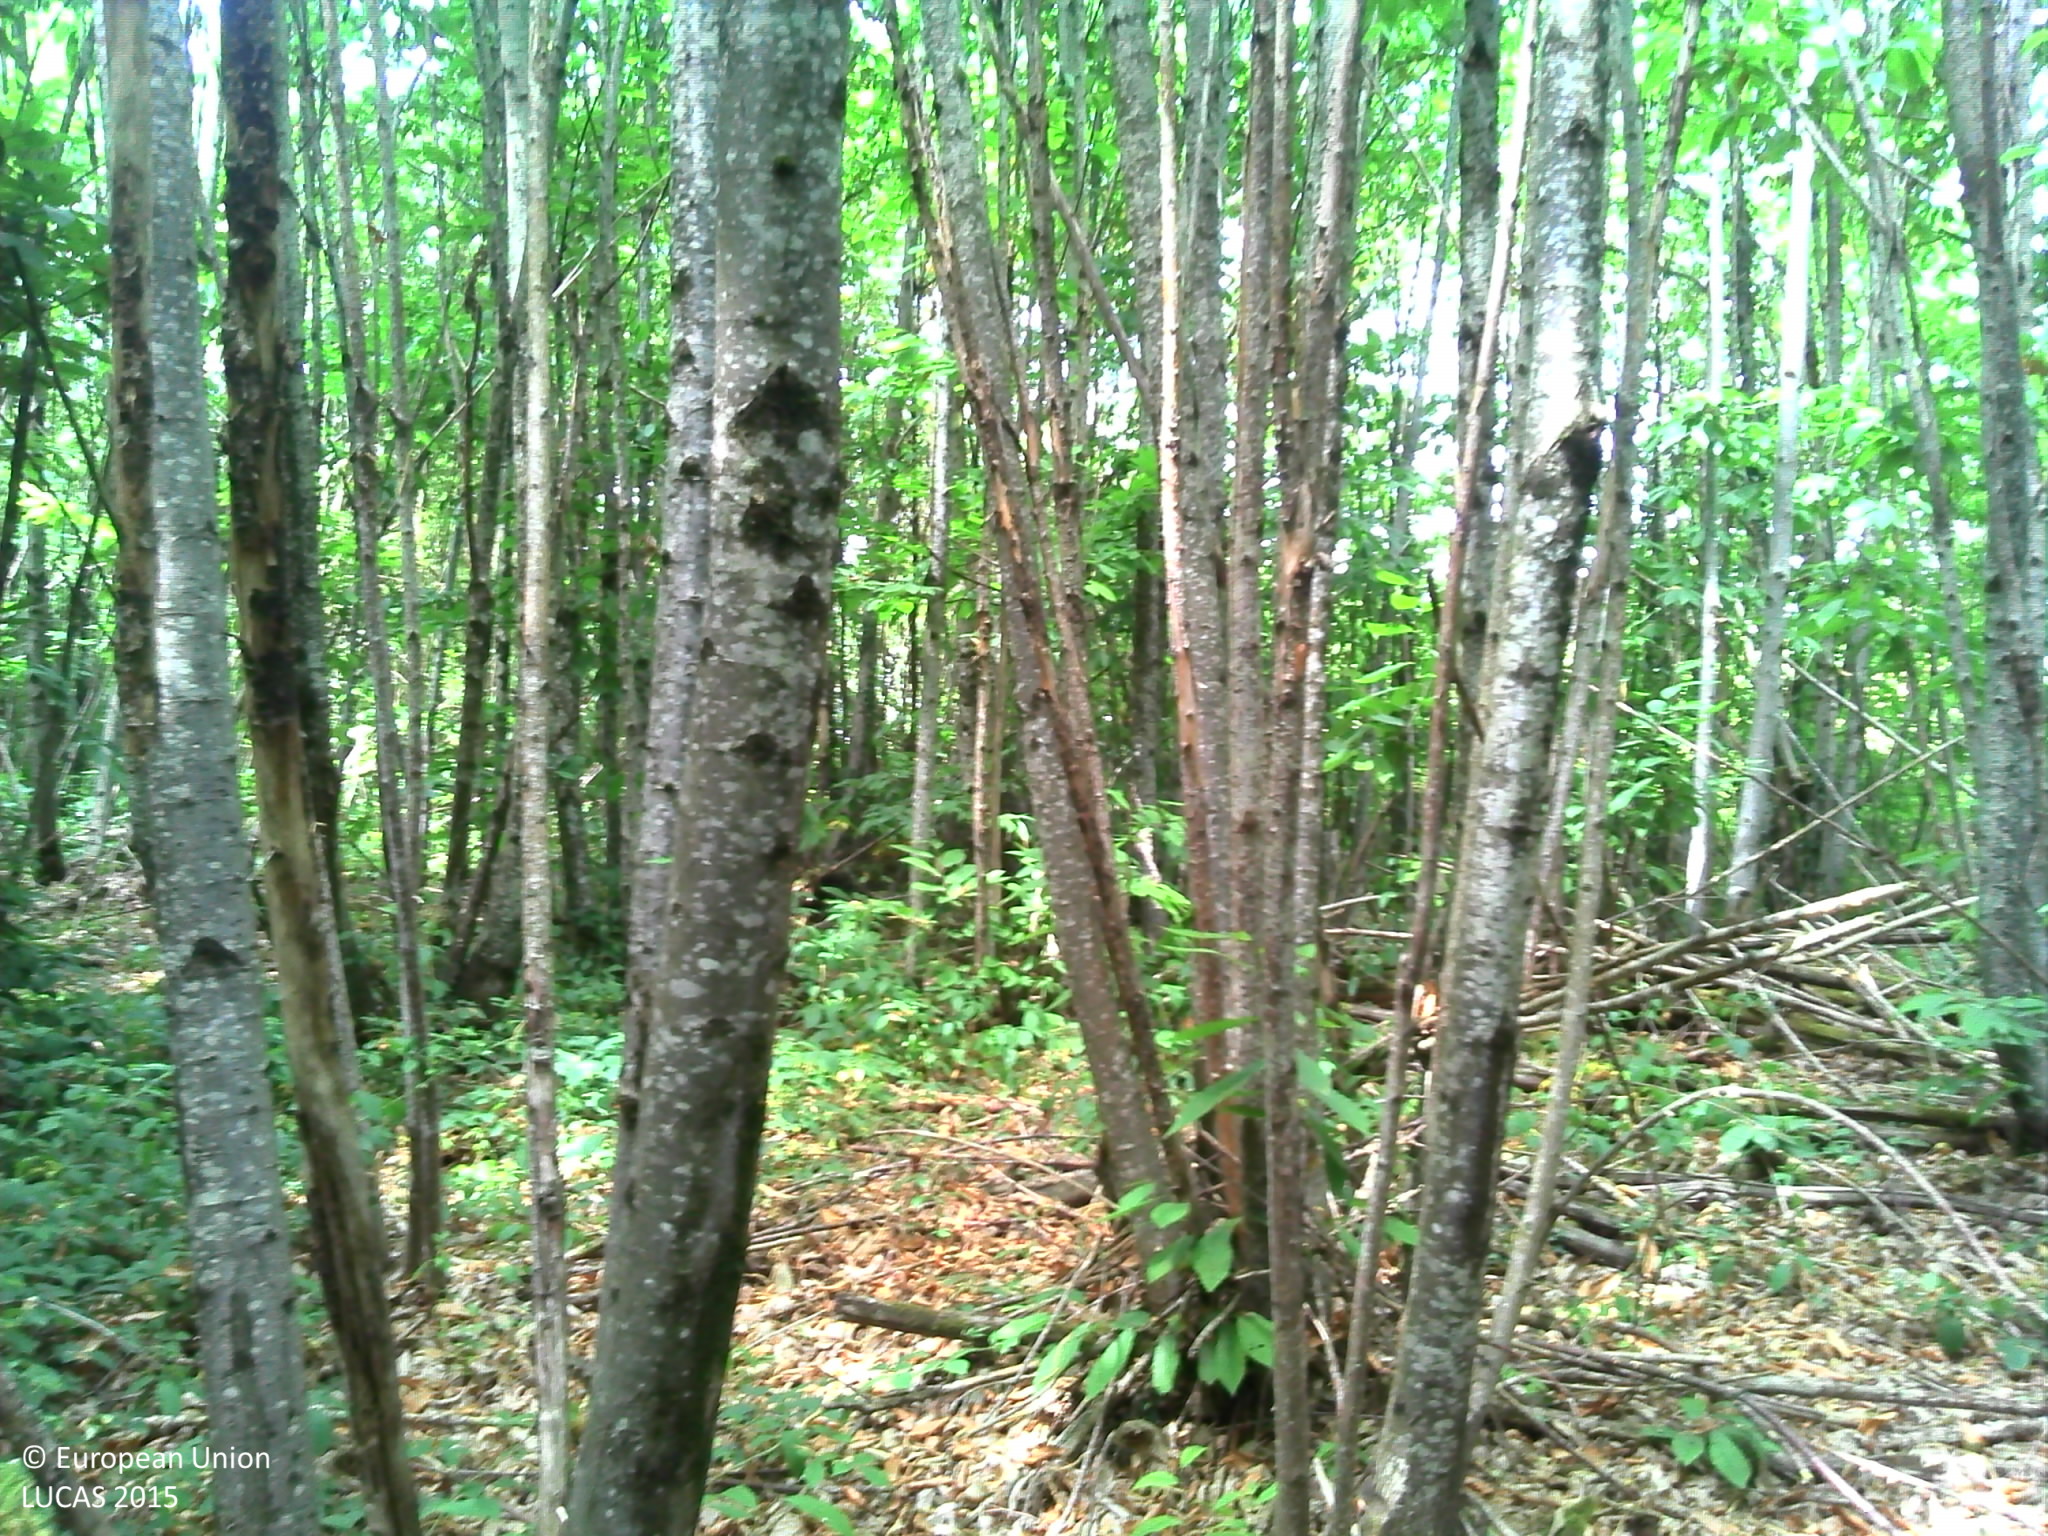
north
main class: Woodland
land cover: Broadleaved woodland
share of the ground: > 75 %
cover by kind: broadleaved forest trees 40 %, herbaceous plants 30 %, lichens and mosses 20 %, unconsolidated bare surface 10 %
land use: Forestry
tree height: > 5 m
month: July
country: FR
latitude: 45.6847
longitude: 1.0407
